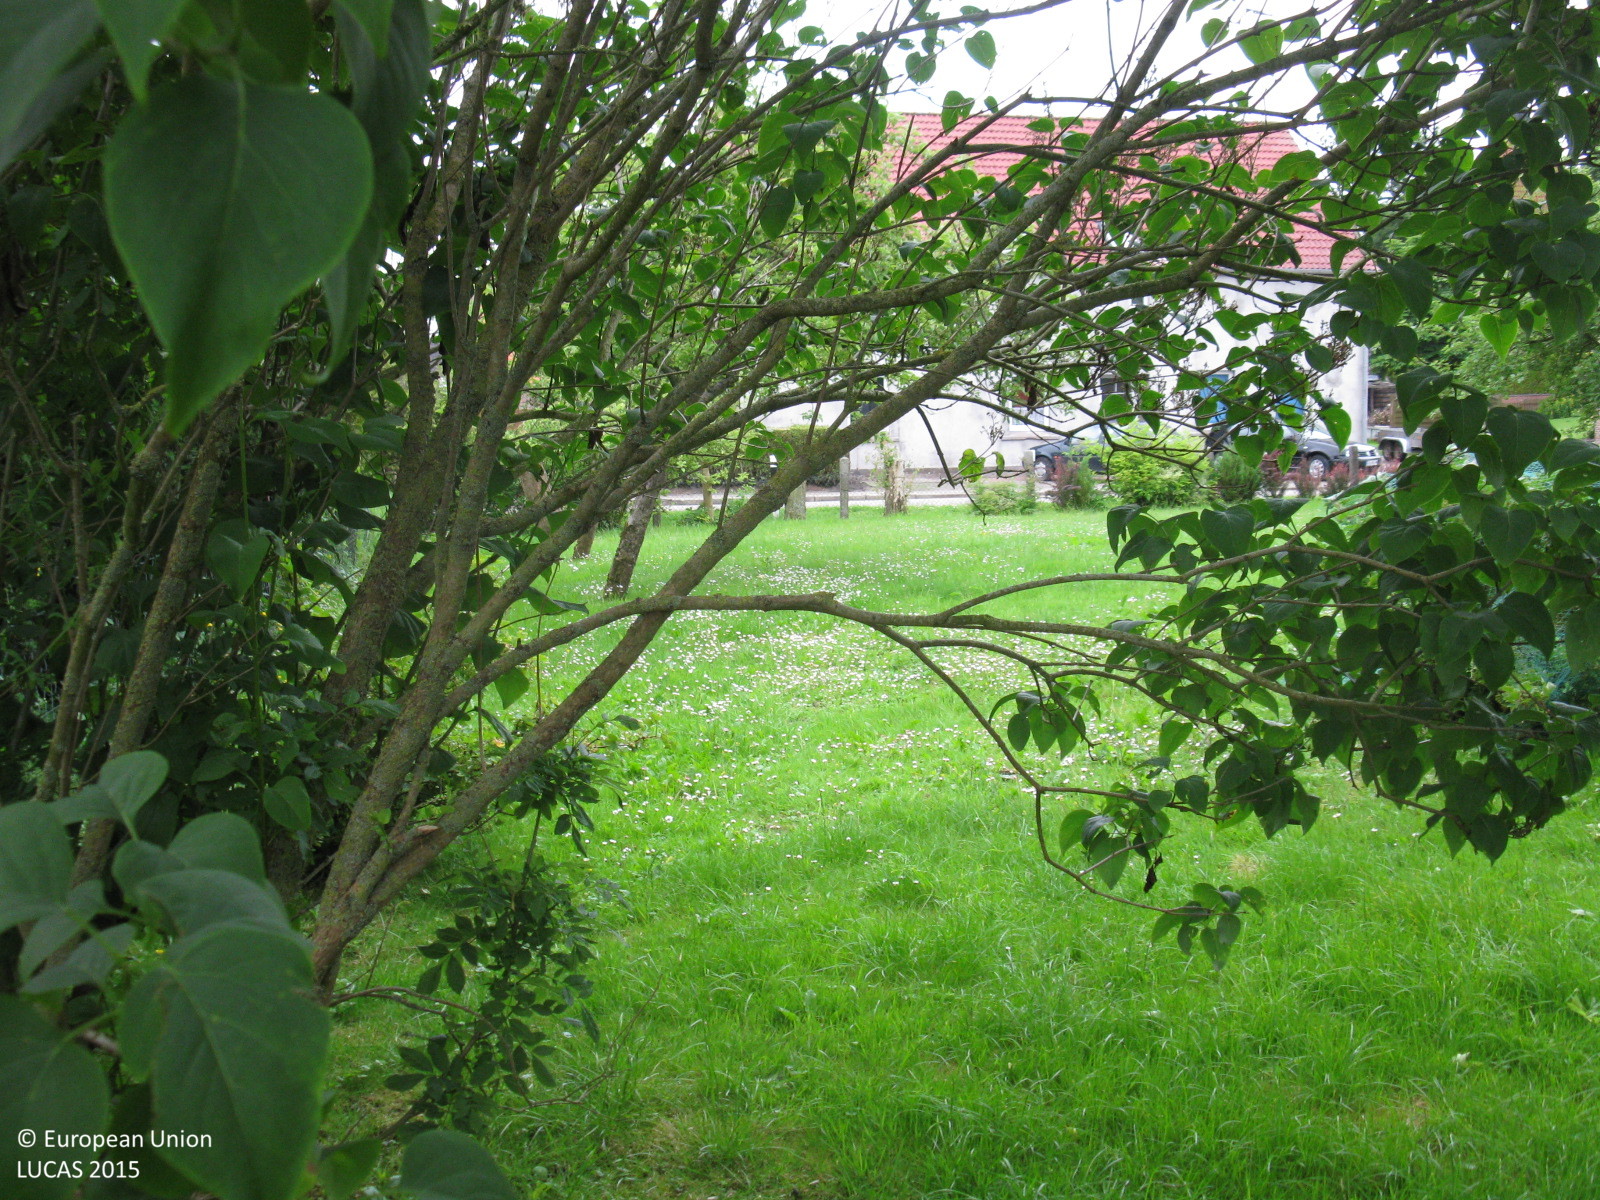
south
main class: Grassland
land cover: Grassland without tree/shrub cover
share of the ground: > 75 %
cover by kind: herbaceous plants 100 %
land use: Agriculture (excluding fallow land and kitchen gardens)
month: June
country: DE
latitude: 53.6359
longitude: 7.9288
